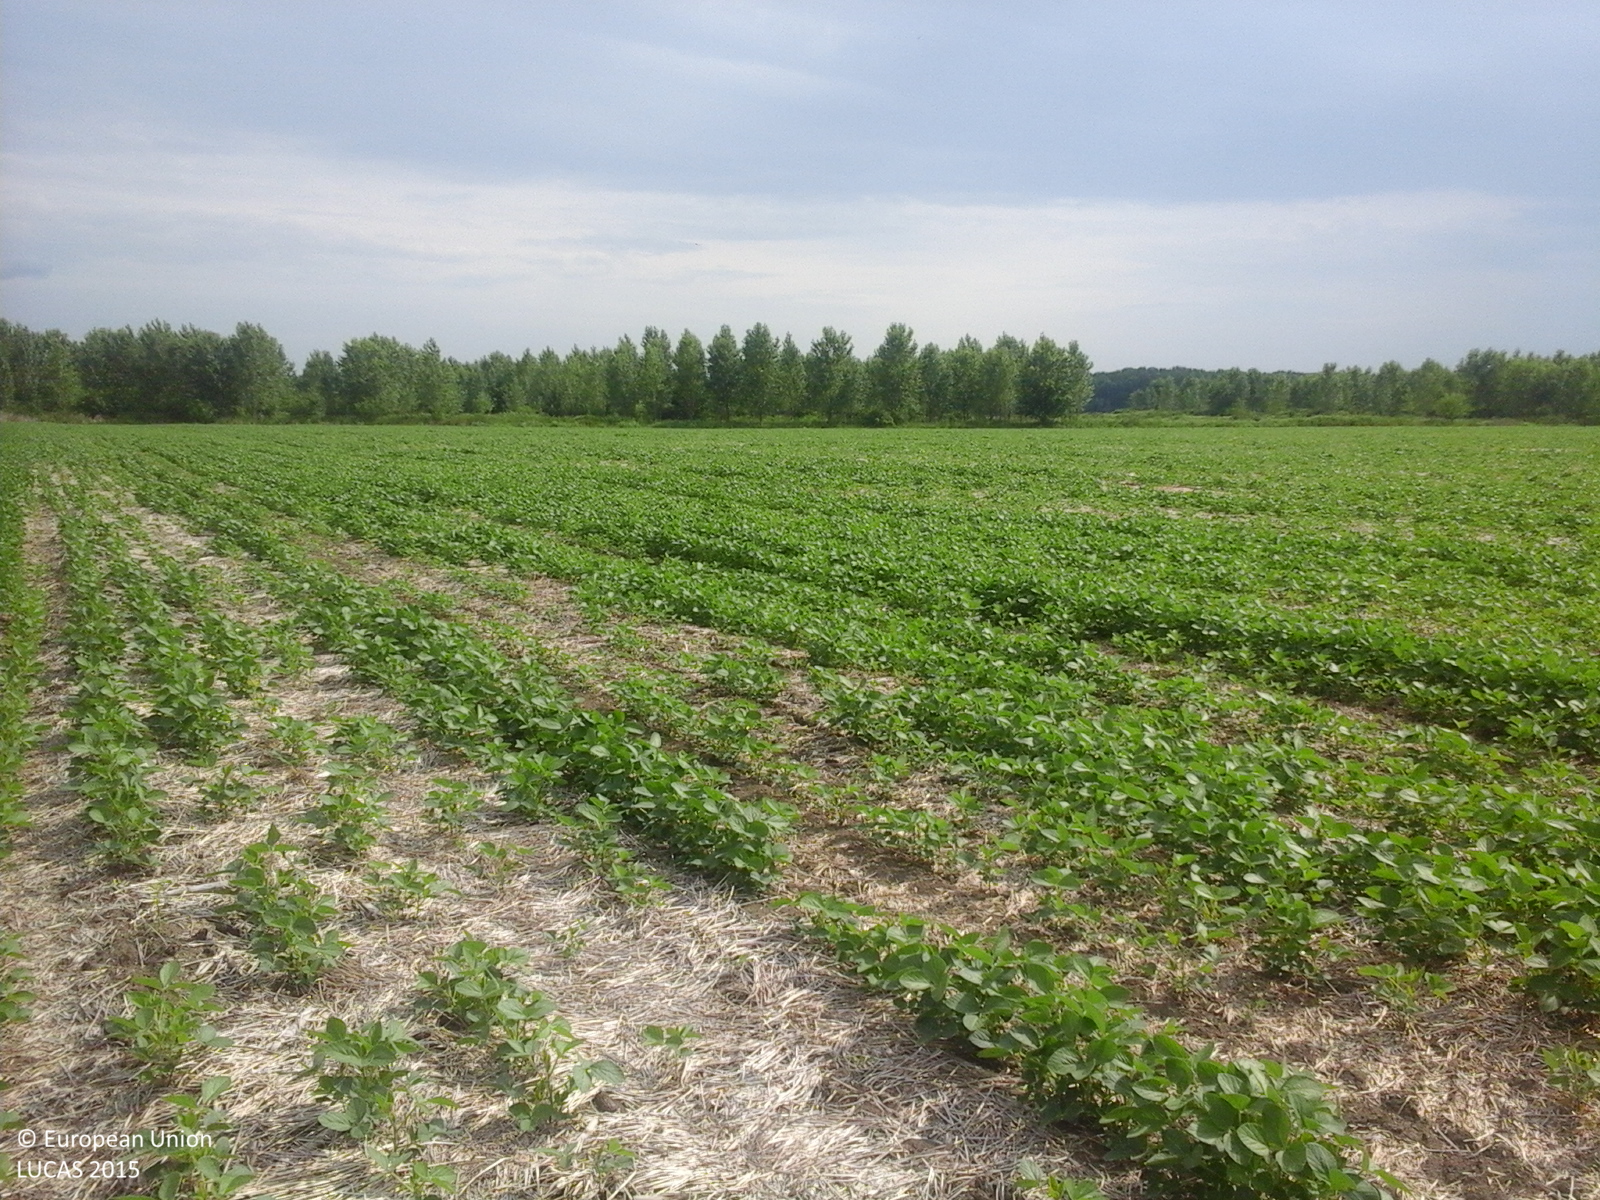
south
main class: Cropland
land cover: Soya
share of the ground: > 75 %
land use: Agriculture (excluding fallow land and kitchen gardens)
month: June
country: RO
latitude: 44.0562
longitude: 26.2191
